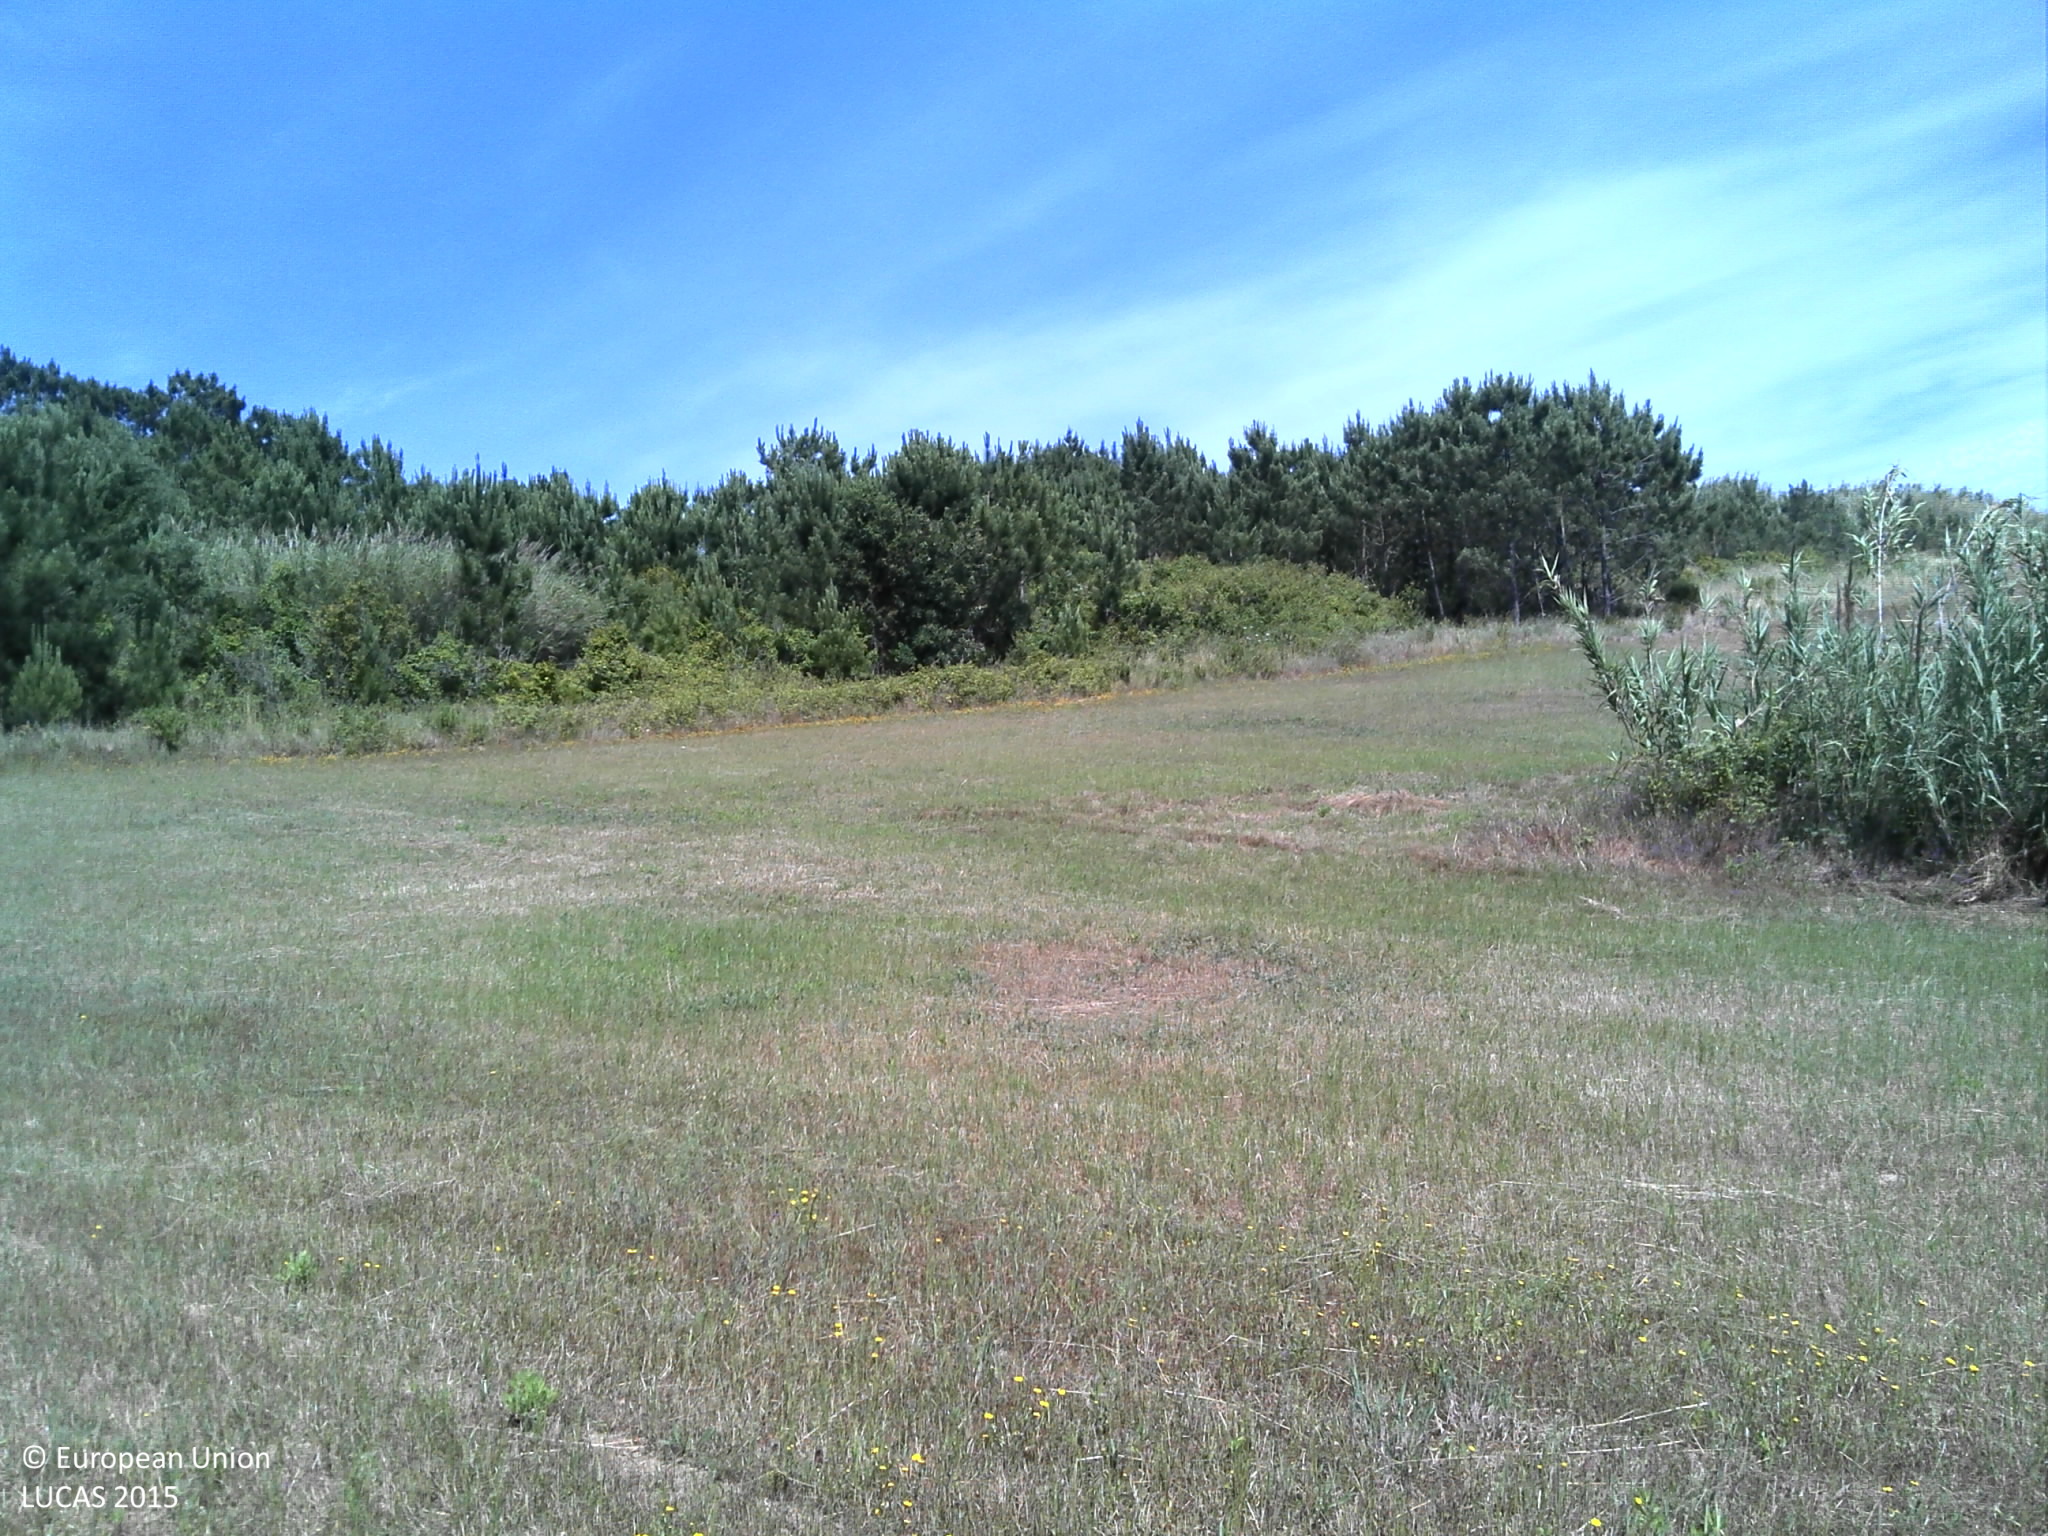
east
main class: Grassland
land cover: Grassland without tree/shrub cover
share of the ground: 50 - 75 %
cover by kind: herbaceous plants 70 %, unconsolidated bare surface 25 %, shrubs 5 %
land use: Agriculture (excluding fallow land and kitchen gardens)
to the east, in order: Grassland without tree/shrub cover; Shrubland with sparse tree cover; Pine dominated coniferous woodland; Ditches and canals; Pine dominated coniferous woodland; Tracks; Pine dominated coniferous woodland; Tracks; Pine dominated coniferous woodland; Tracks; Pine dominated coniferous woodland; Tracks; Pine dominated coniferous woodland; Artificial constructions in urban areas
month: June
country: PT
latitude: 39.2540
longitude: -9.3162
